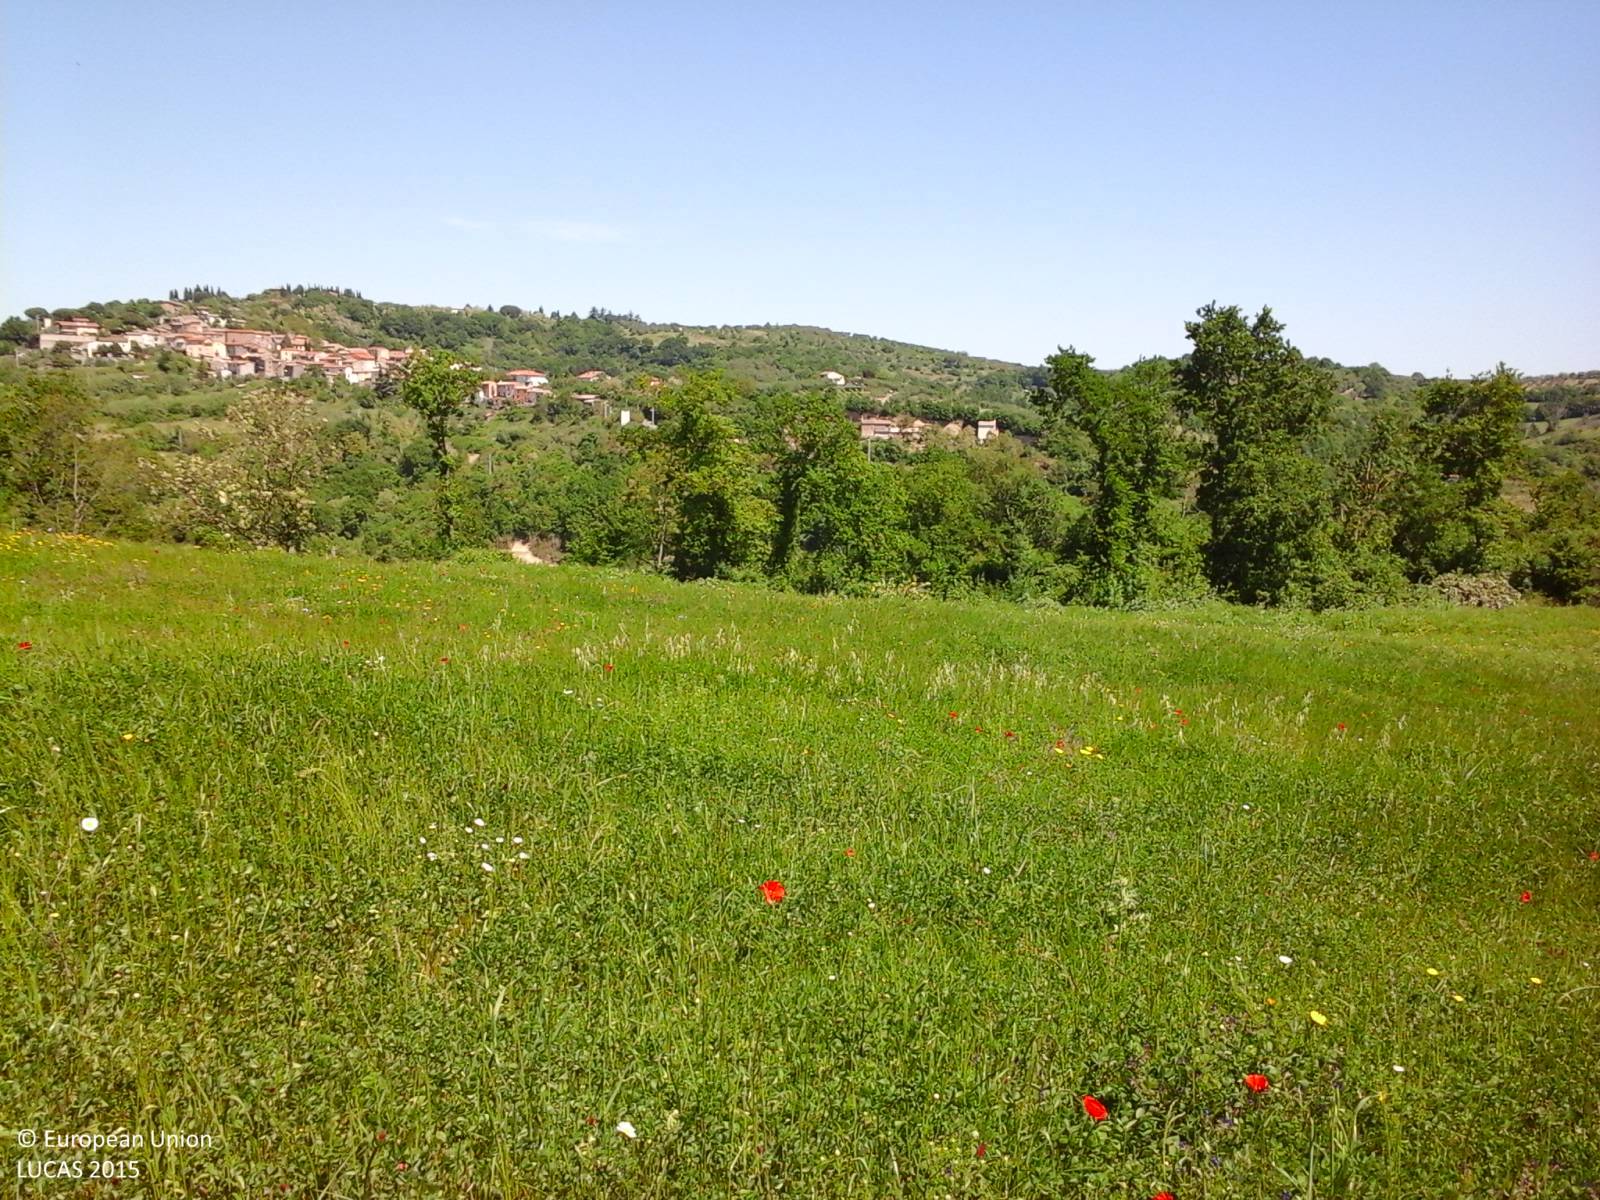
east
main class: Cropland
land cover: Lucerne
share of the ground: > 75 %
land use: Agriculture (excluding fallow land and kitchen gardens)
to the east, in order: Lucerne; Broadleaved woodland
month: May
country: IT
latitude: 42.5585
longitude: 12.1730
